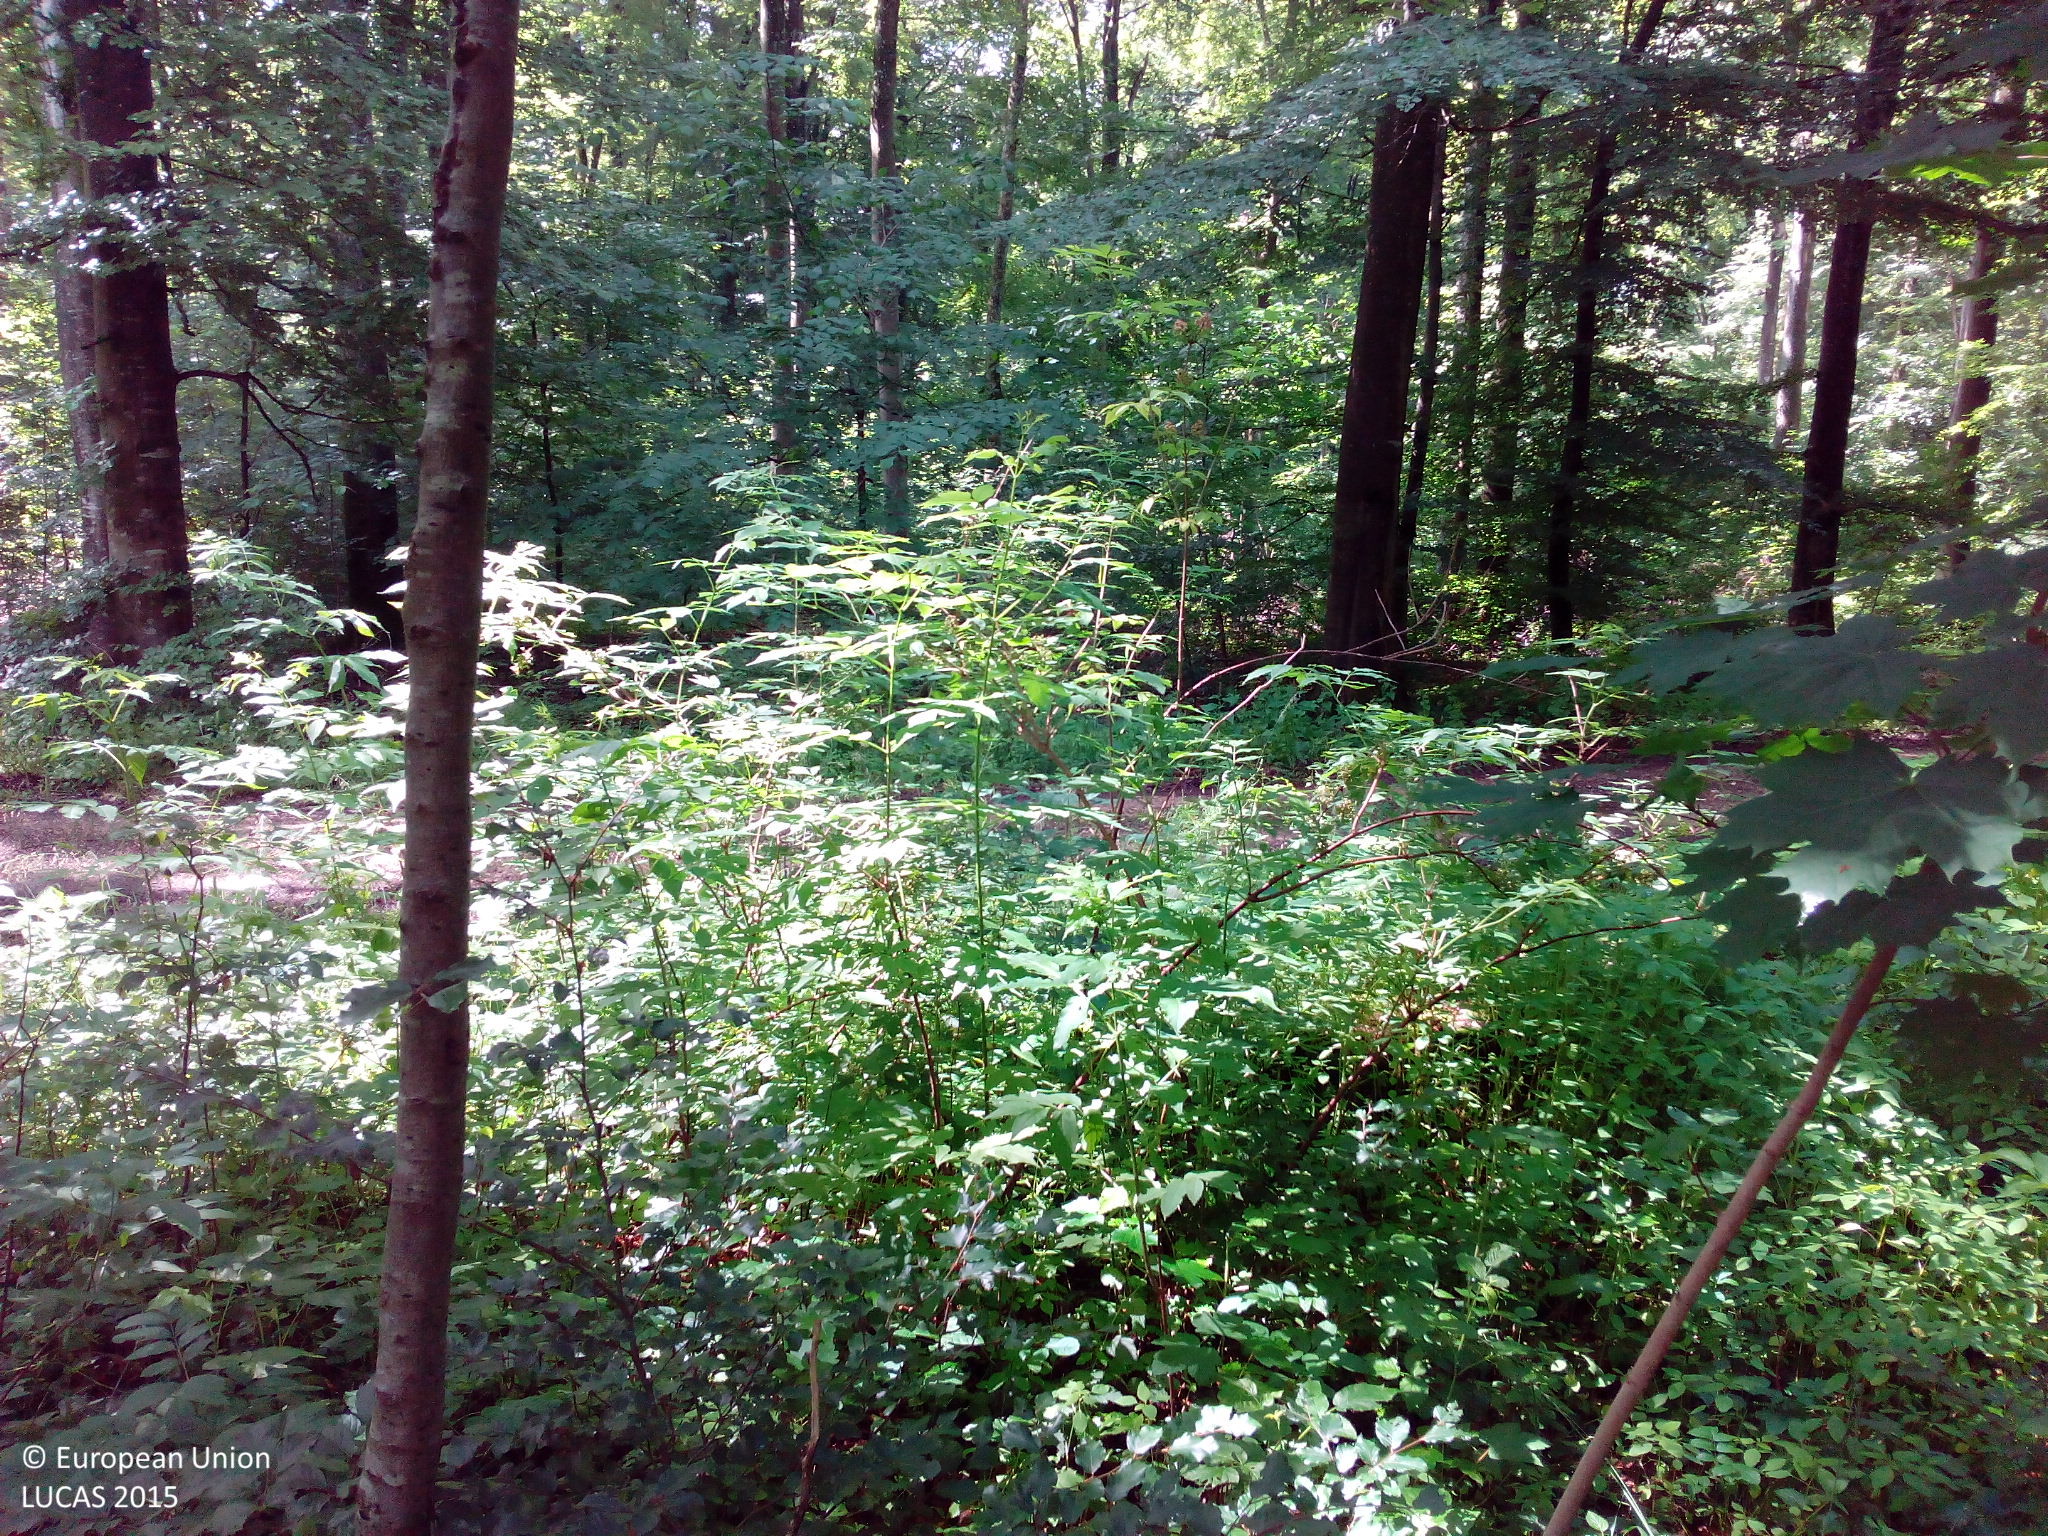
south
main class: Woodland
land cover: Broadleaved woodland
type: mesophytic deciduous forest
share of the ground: > 75 %
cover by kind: broadleaved forest trees 90 %, shrubs 5 %, herbaceous plants 5 %
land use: Forestry
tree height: > 5 m
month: June
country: DE
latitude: 48.5459
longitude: 9.4178
